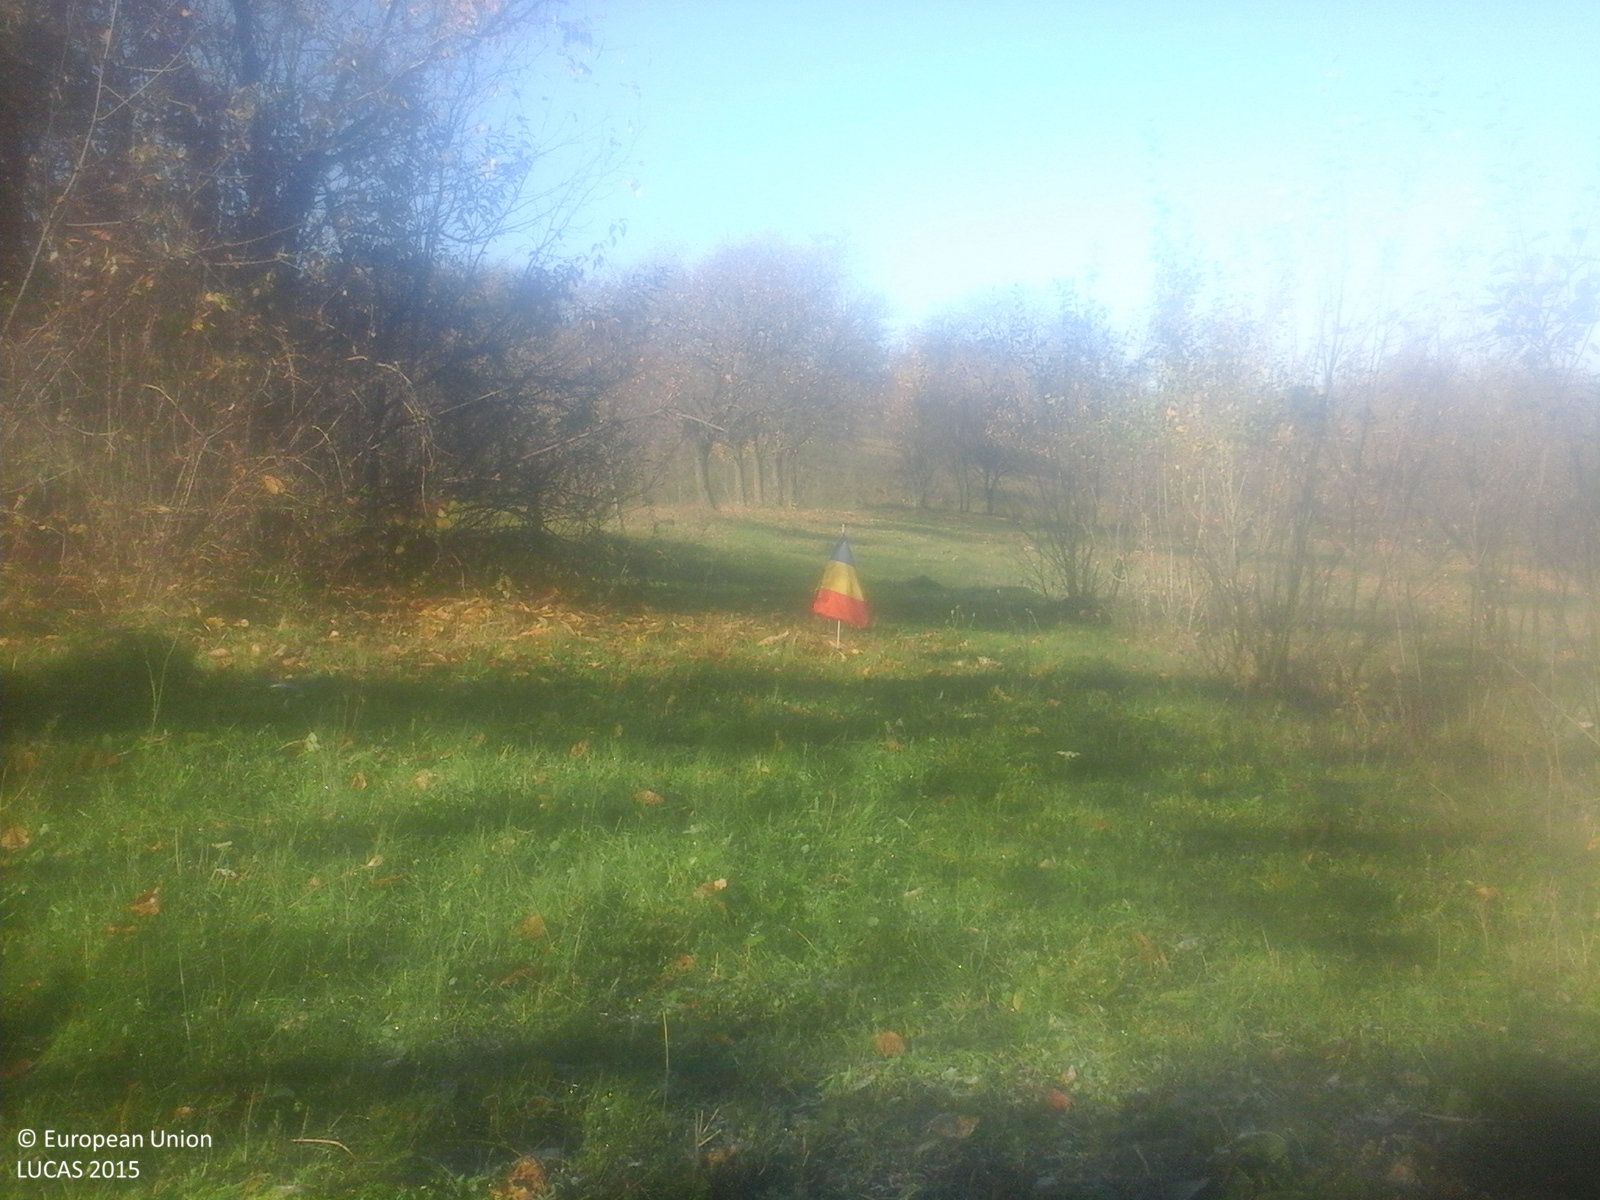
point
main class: Cropland
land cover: Other fruit trees and berries
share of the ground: > 75 %
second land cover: Grassland without tree/shrub cover
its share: > 75 %
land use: Agriculture (excluding fallow land and kitchen gardens)
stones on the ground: < 10 %
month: October
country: RO
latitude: 45.9031
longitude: 26.9631
